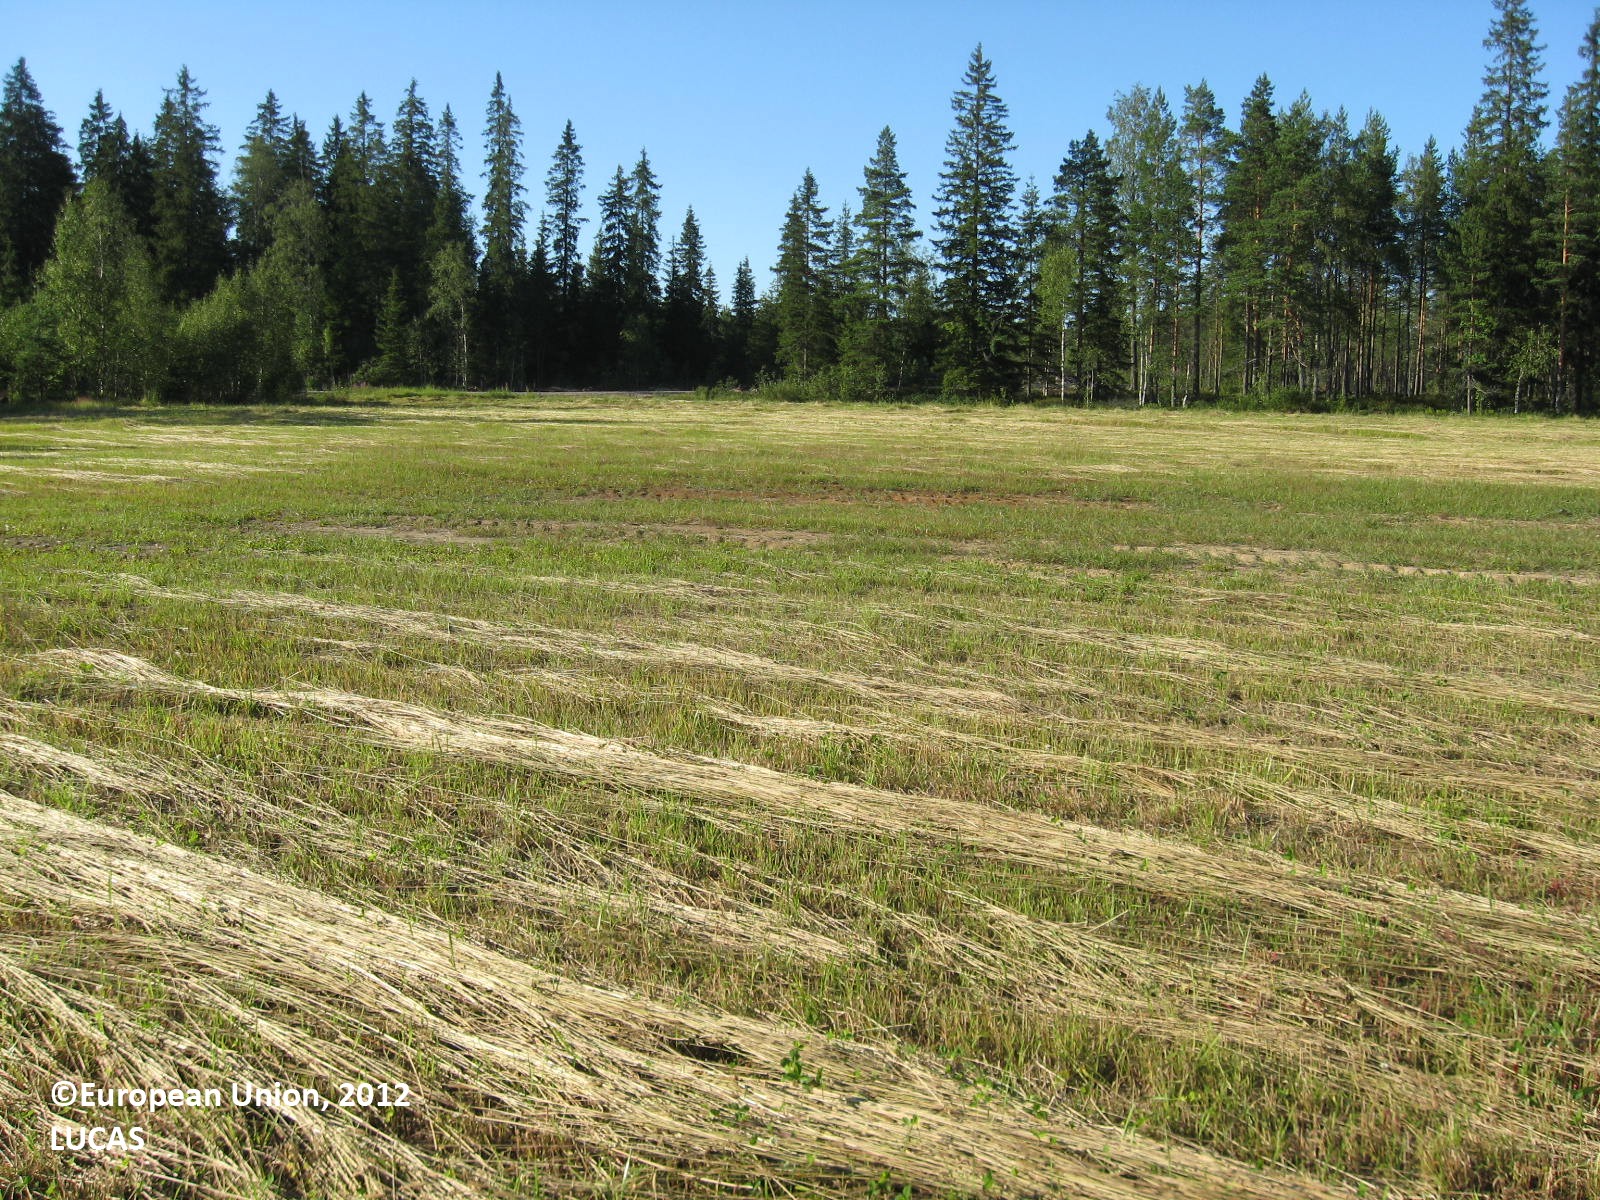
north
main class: Cropland
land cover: Temporary grasslands
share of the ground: > 75 %
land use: Agriculture (excluding fallow land and kitchen gardens)
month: July
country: FI
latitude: 62.1110
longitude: 22.4570
